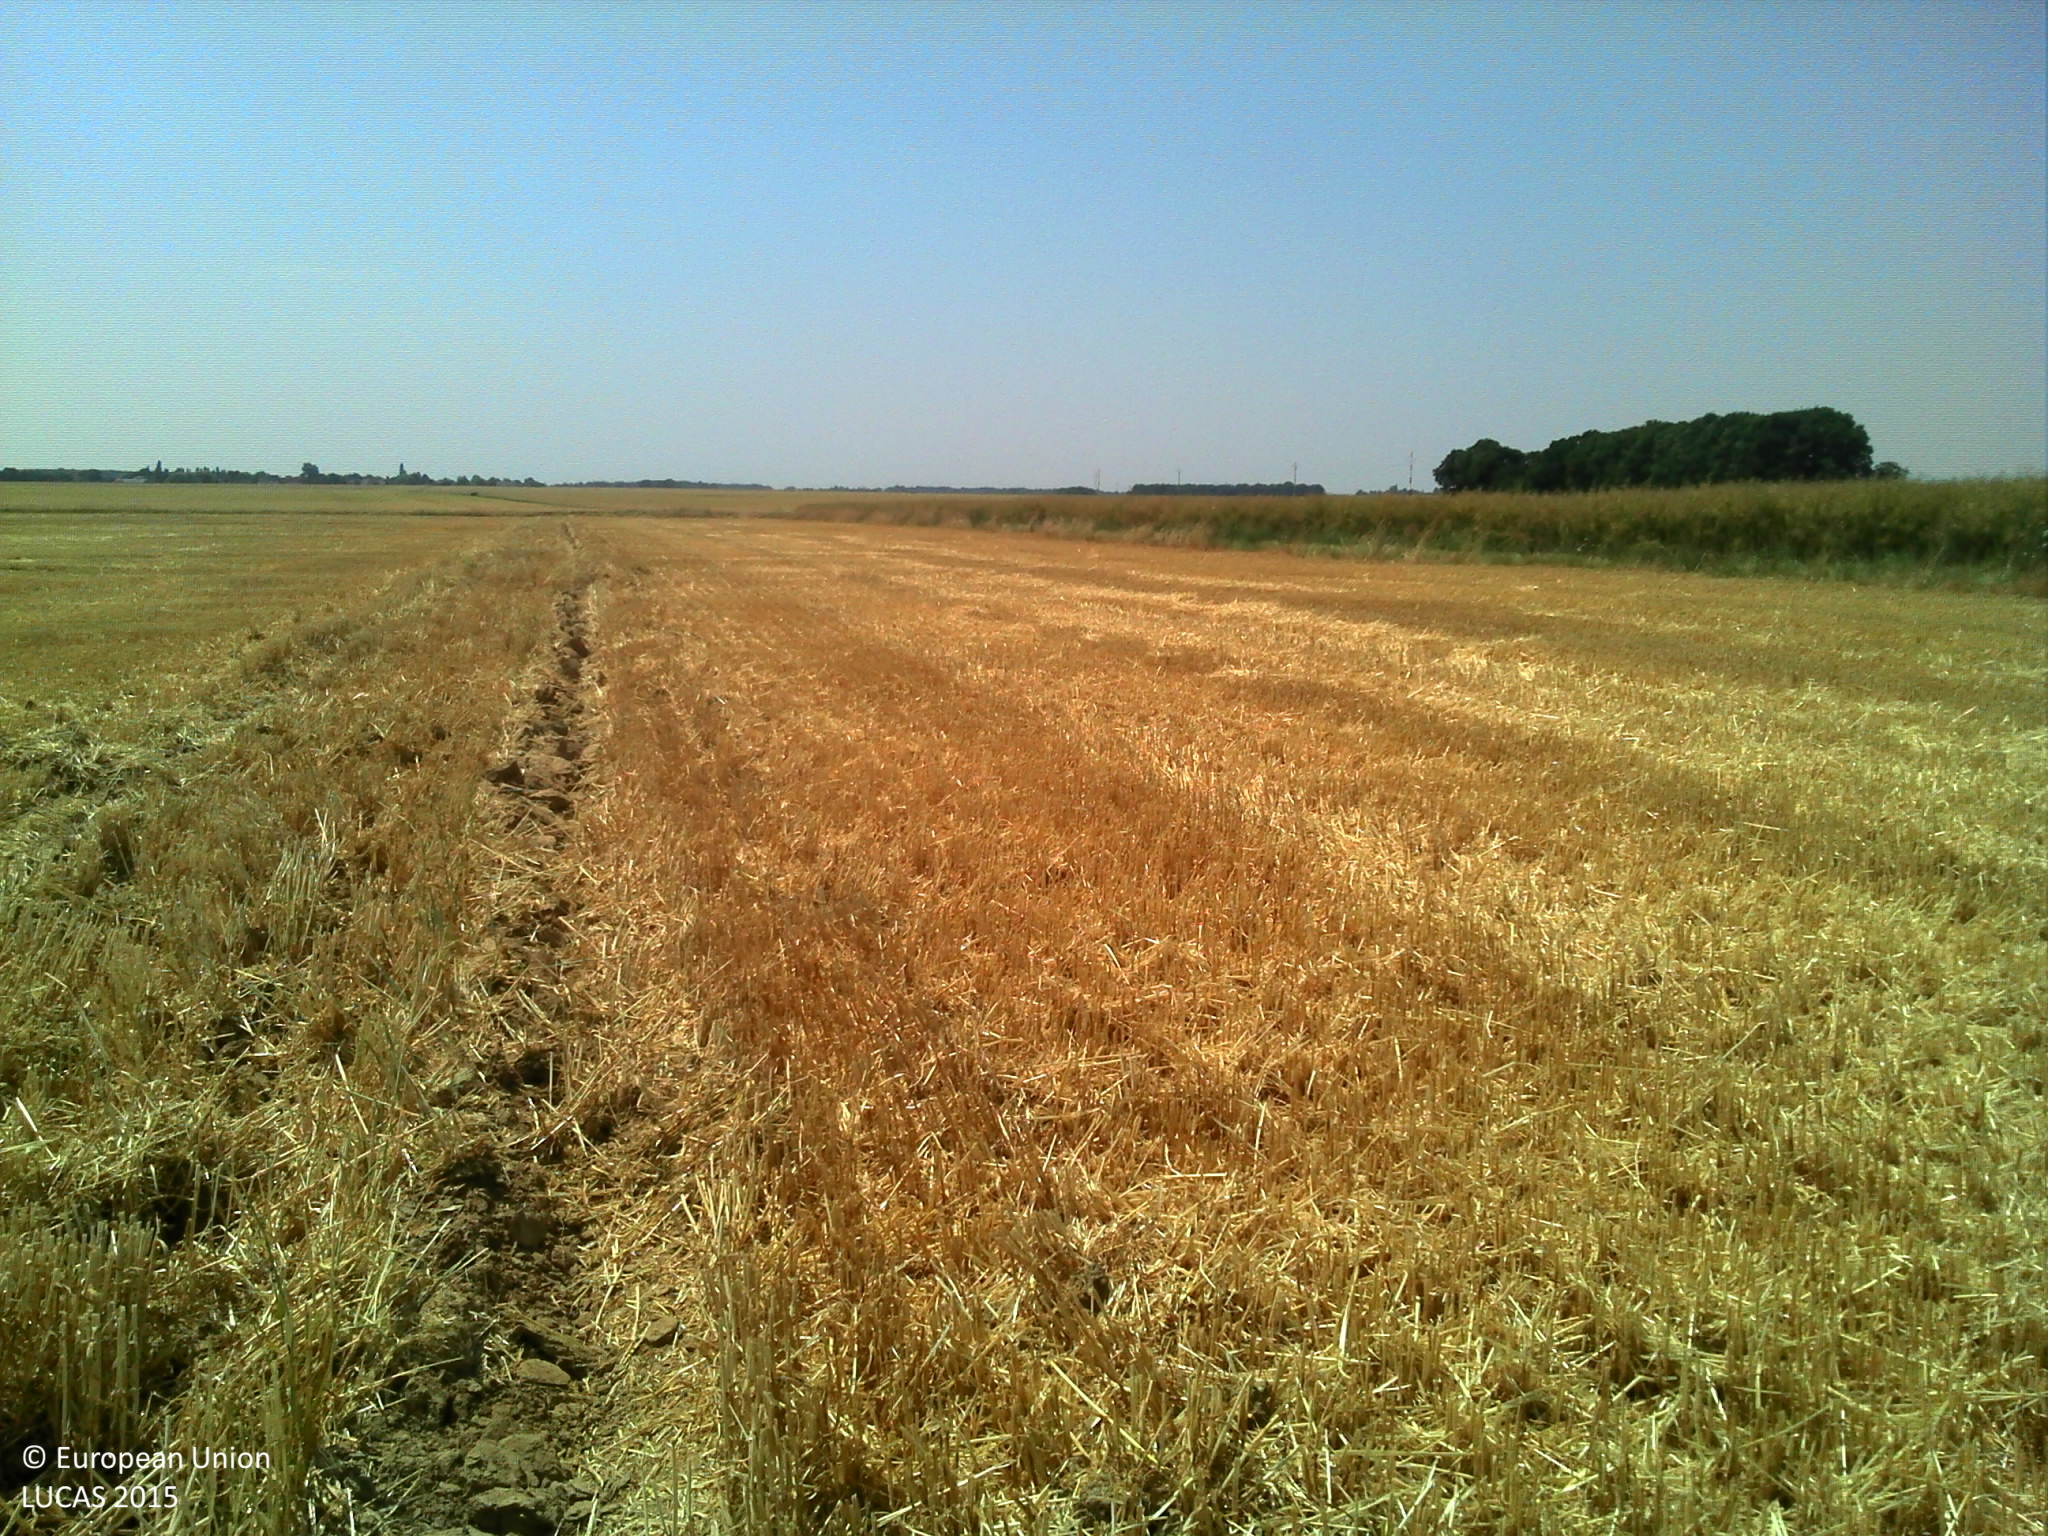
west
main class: Cropland
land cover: Barley
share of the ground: > 75 %
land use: Agriculture (excluding fallow land and kitchen gardens)
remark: Harvested field
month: July
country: FR
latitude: 48.9076
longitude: 1.2624
